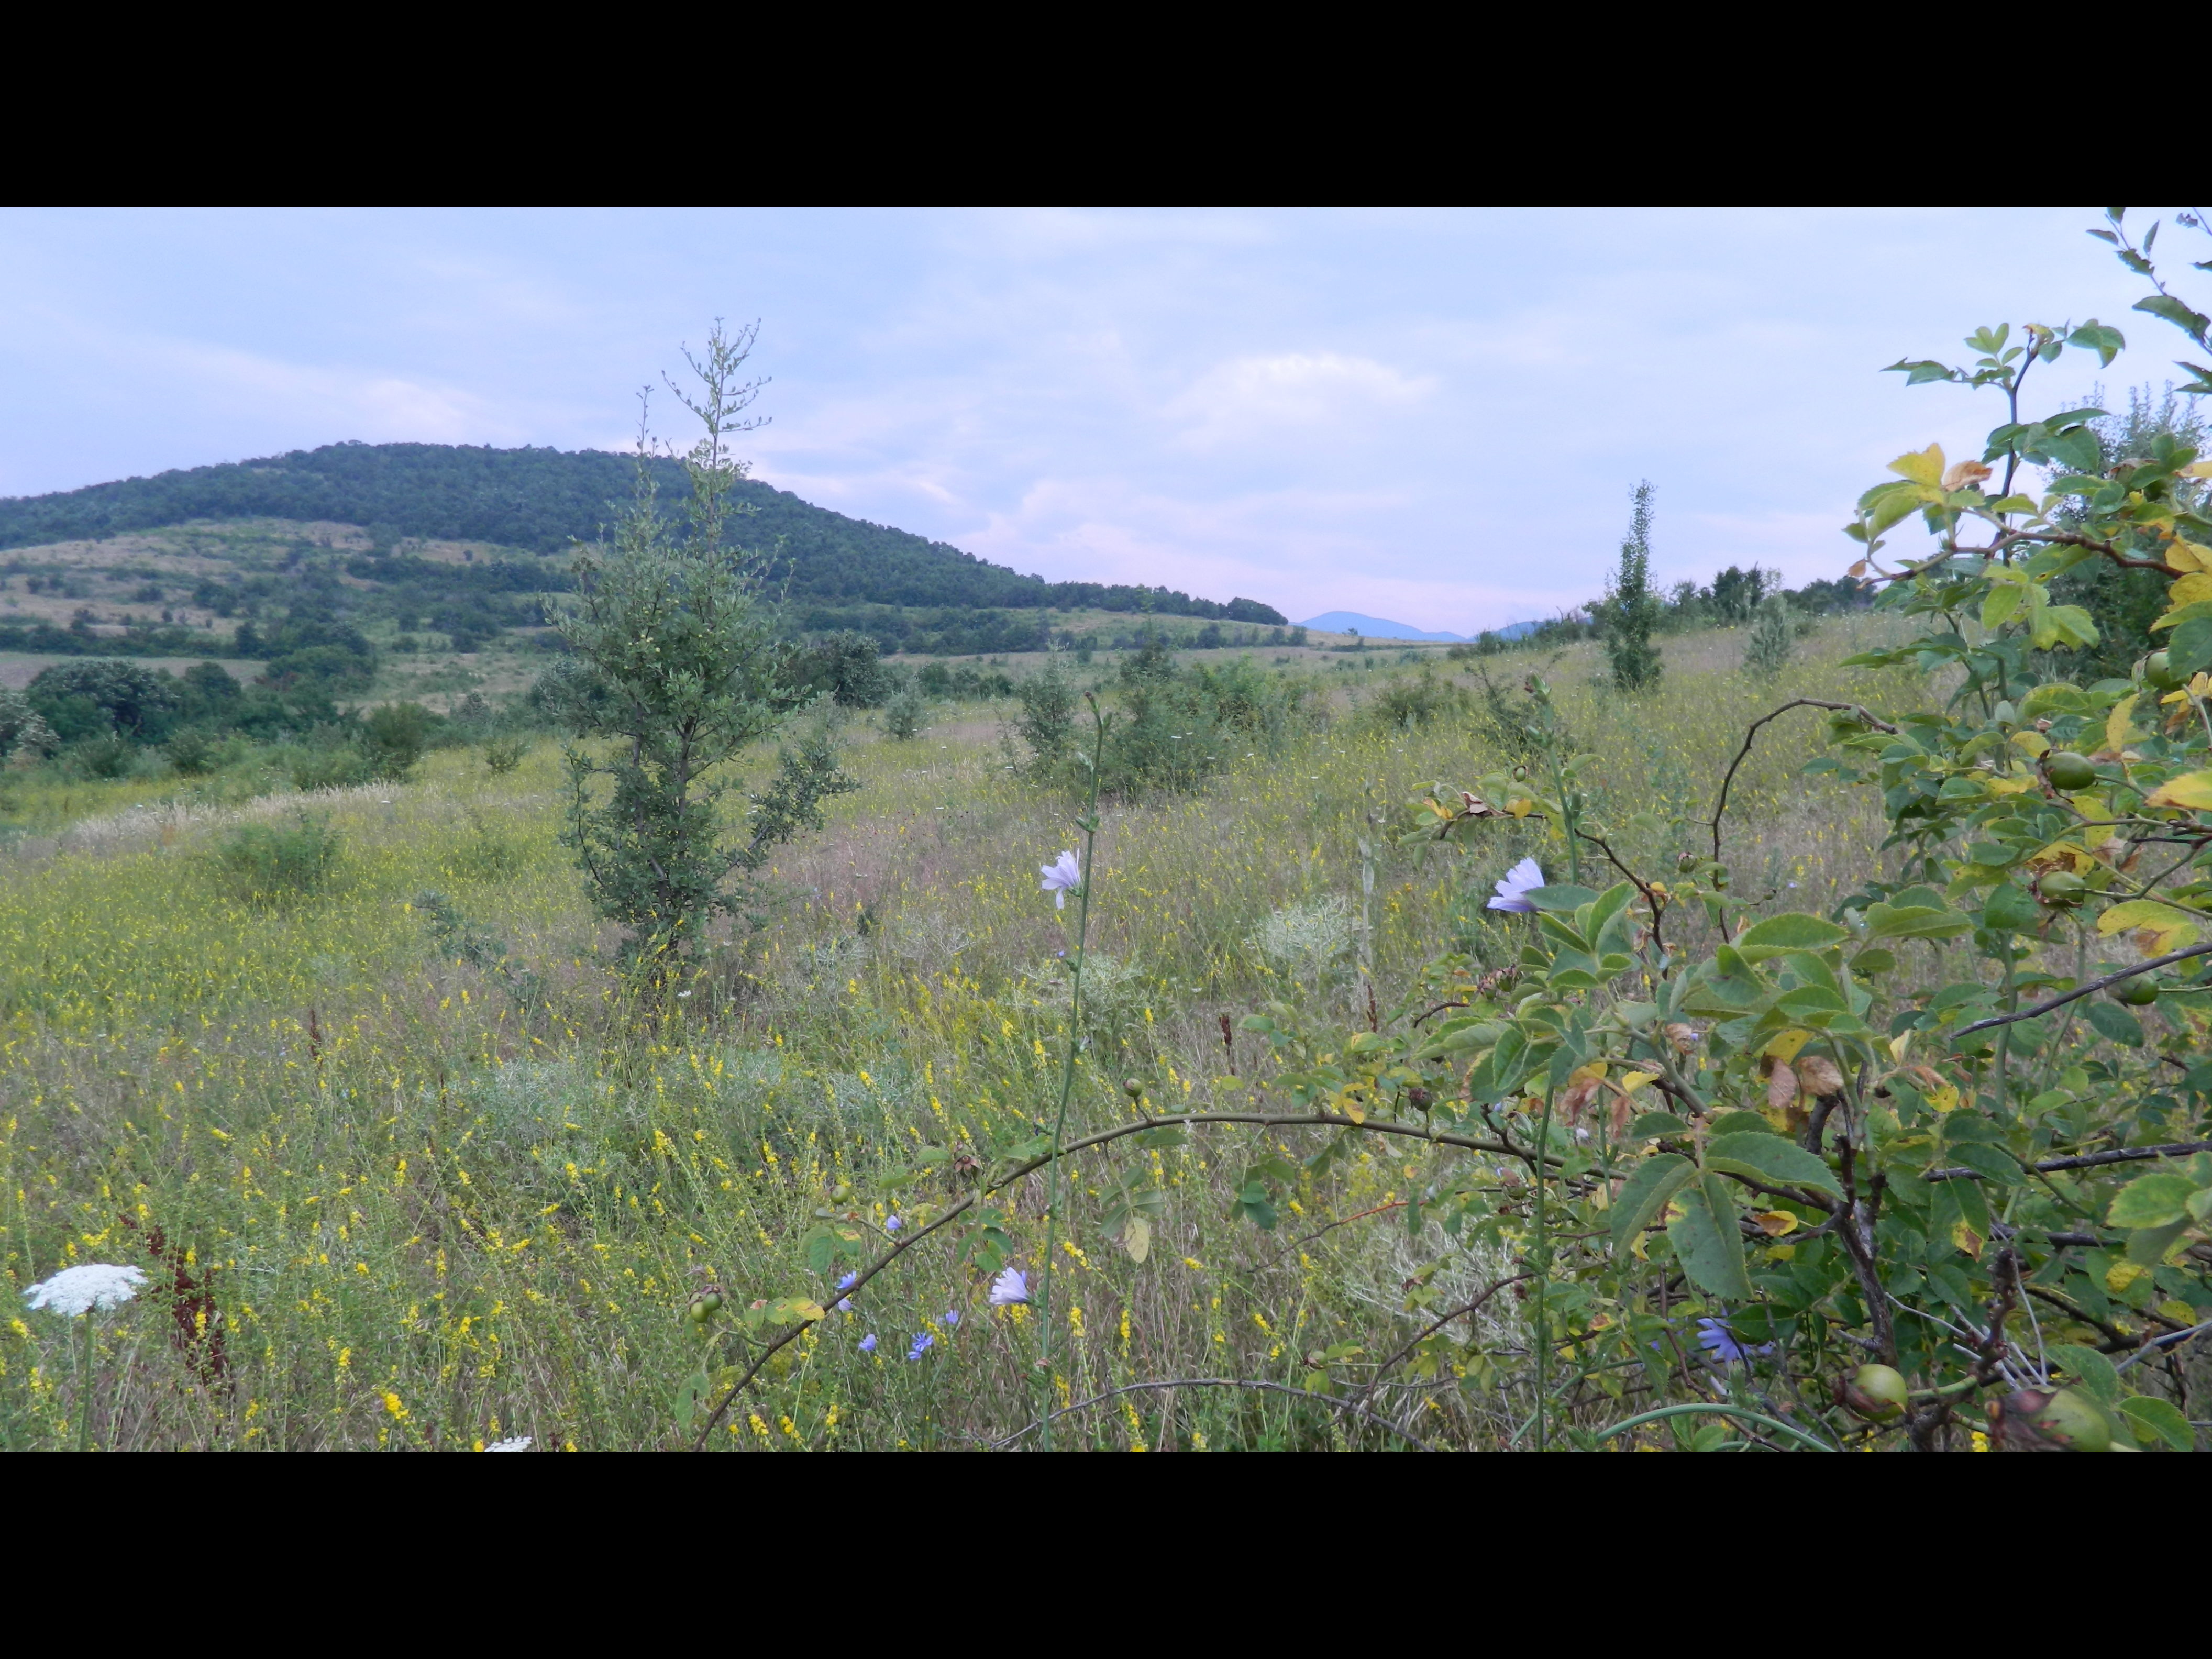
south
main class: Shrubland
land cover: Shrubland without tree cover
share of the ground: 25 - 50 %
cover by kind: herbaceous plants 60 %, shrubs 40 %
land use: Semi-natural and natural areas not in use
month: July
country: BG
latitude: 41.9122
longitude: 25.1382
